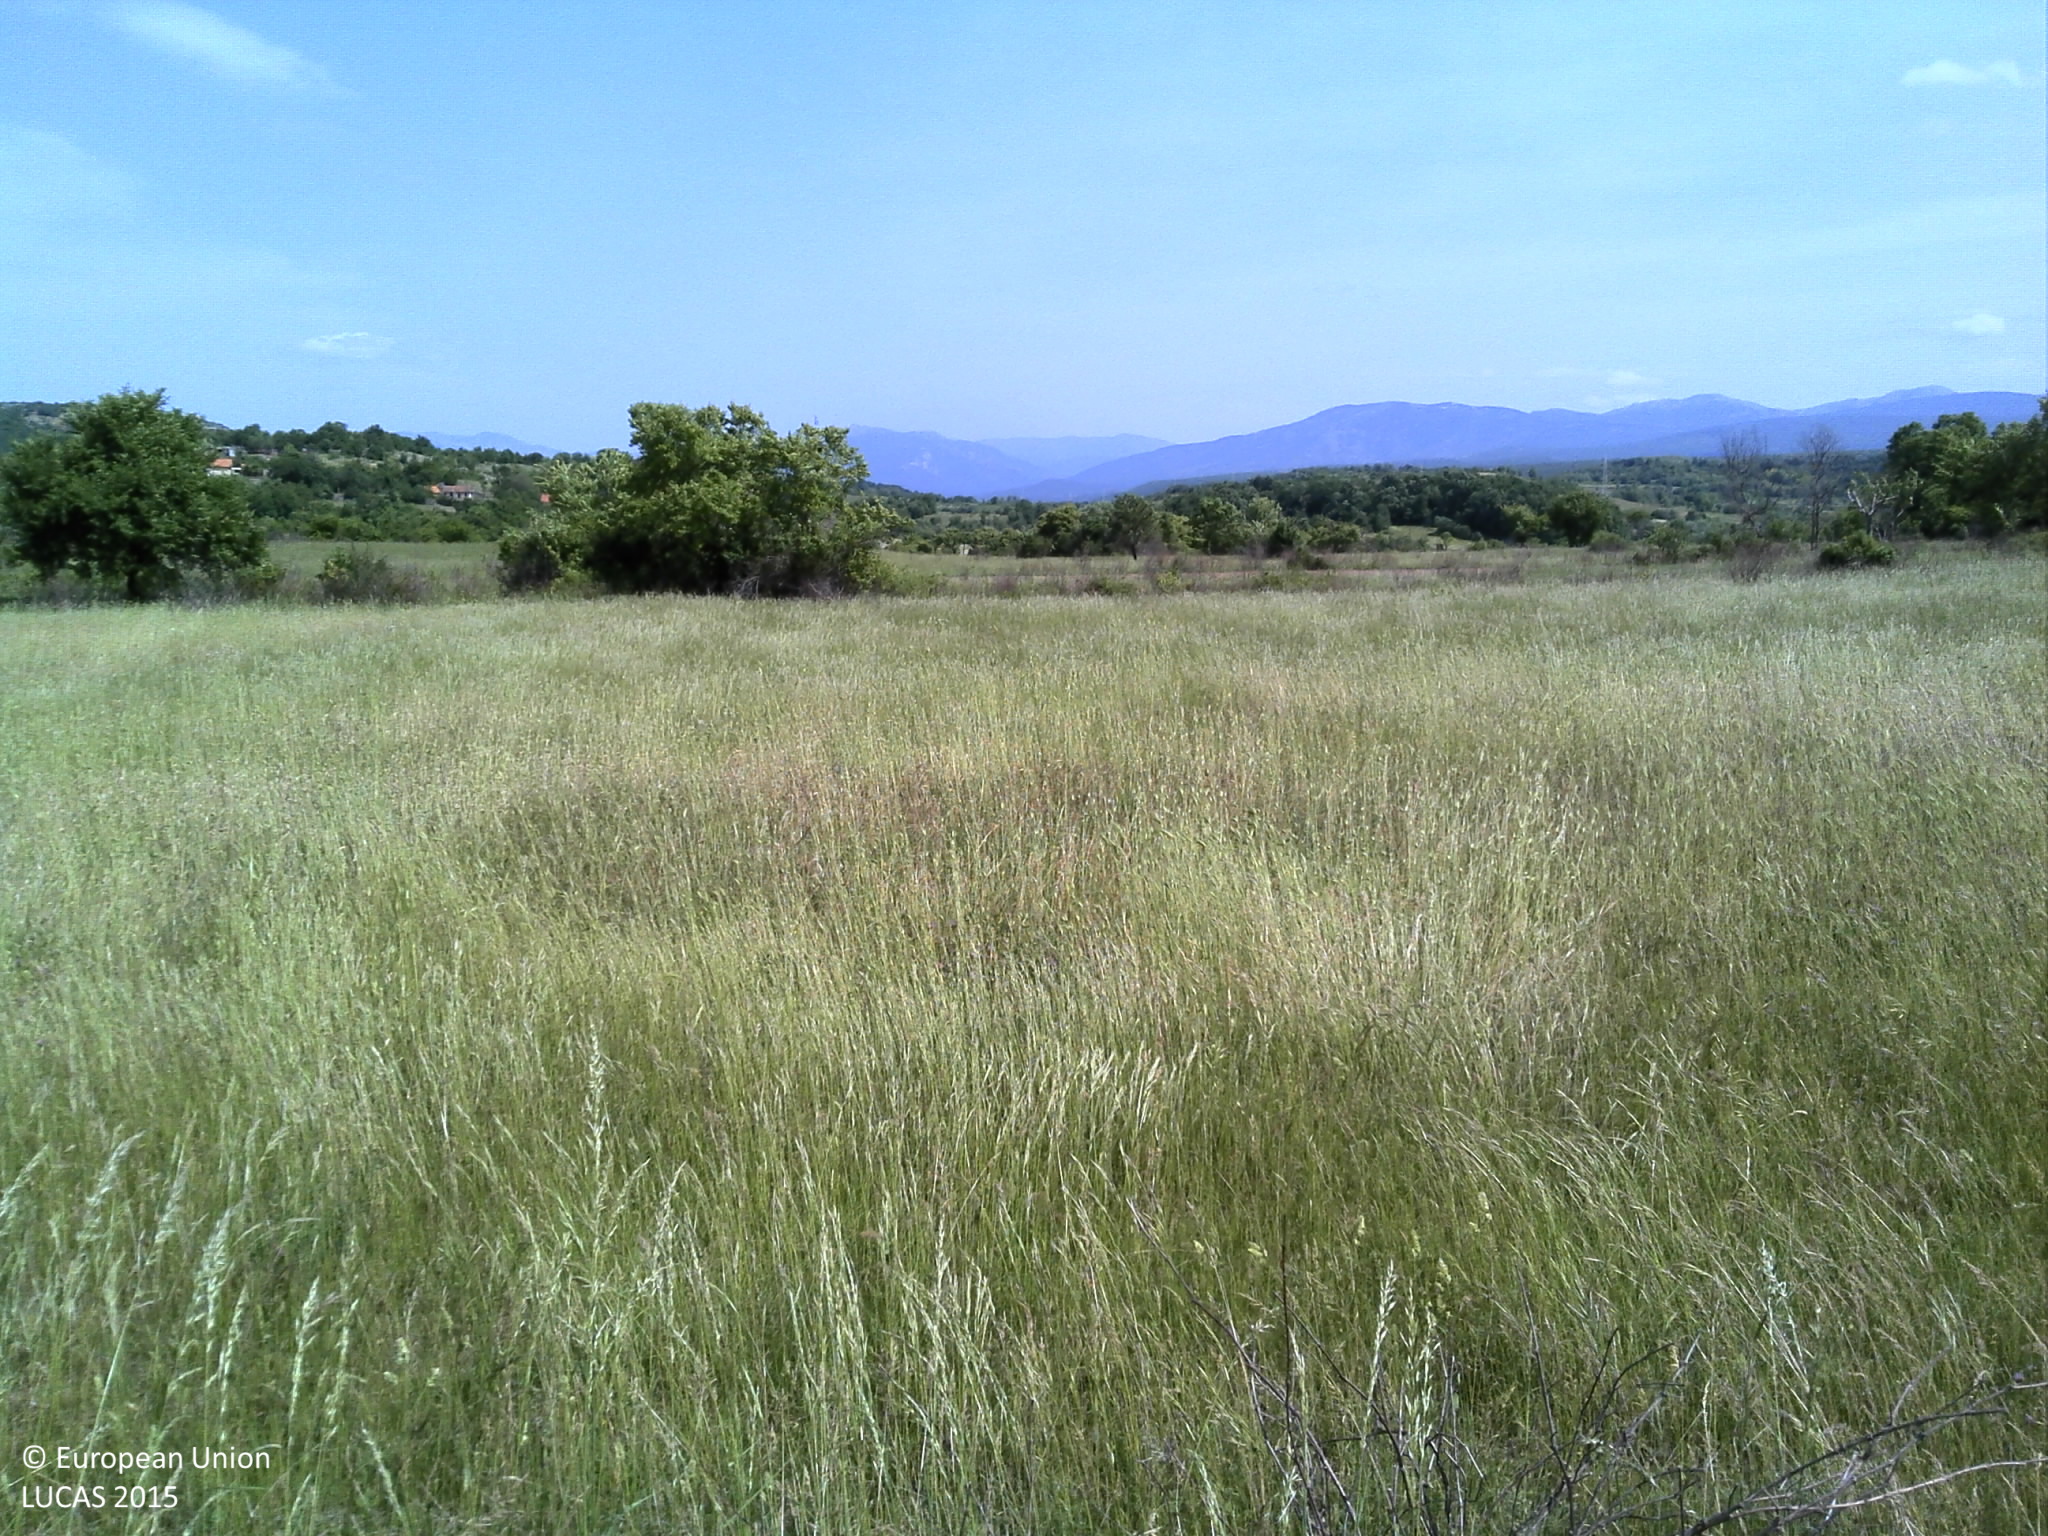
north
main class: Grassland
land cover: Grassland with sparse tree/shrub cover
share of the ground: > 75 %
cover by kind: herbaceous plants 85 %, shrubs 10 %, broadleaved forest trees 5 %
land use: Abandoned areas
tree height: < 5 m
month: May
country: HR
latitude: 43.9655
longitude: 16.2116
